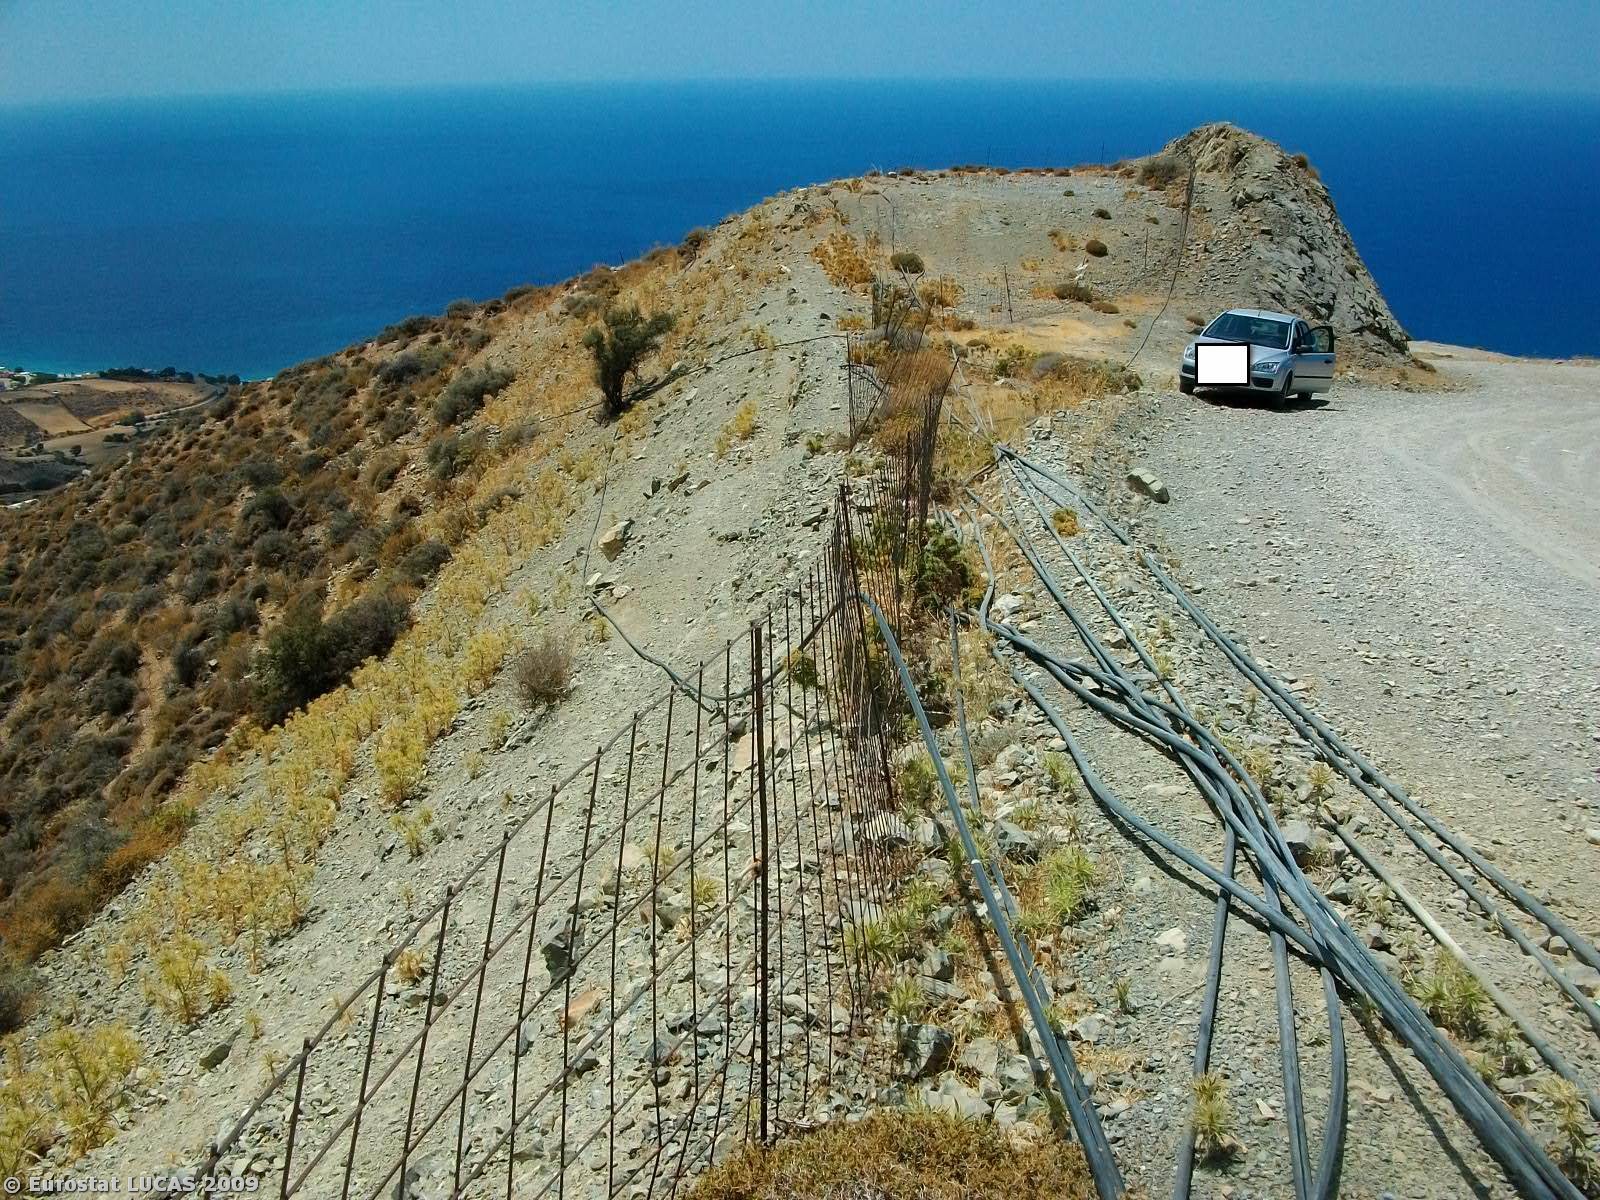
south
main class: Shrubland
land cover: Shrubland without tree cover
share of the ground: > 75 %
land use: Agriculture (excluding fallow land and kitchen gardens)
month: July
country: GR
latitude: 34.9441
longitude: 24.9068
